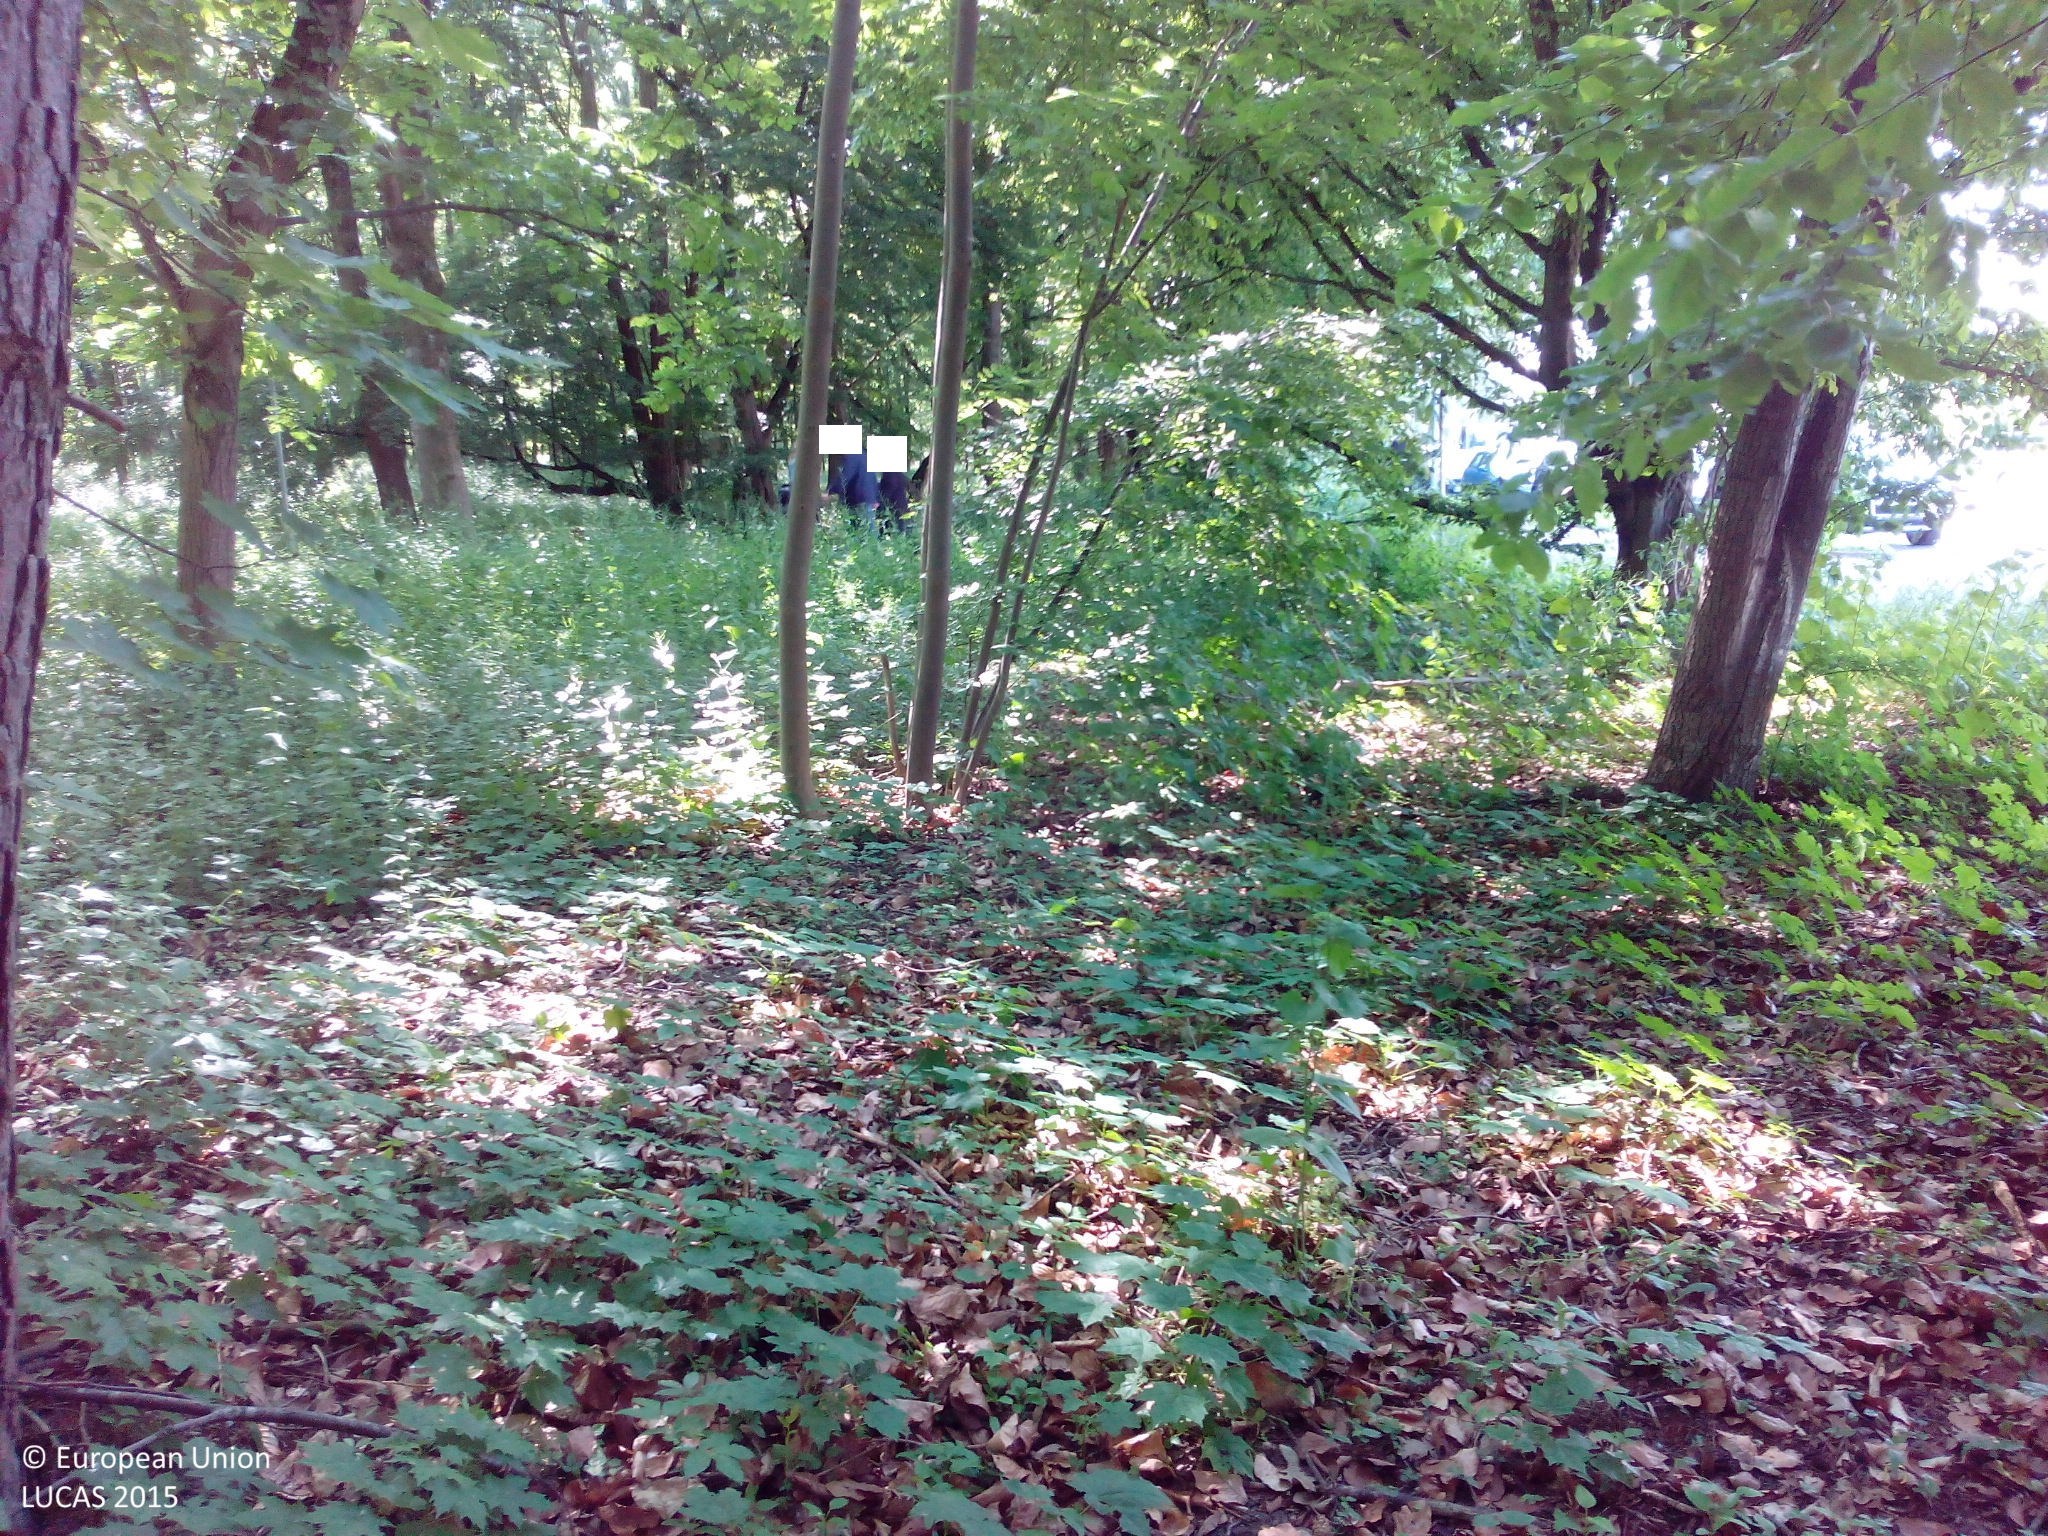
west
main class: Woodland
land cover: Broadleaved woodland
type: mesophytic deciduous forest
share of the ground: > 75 %
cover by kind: broadleaved forest trees 90 %, coniferous forest trees 5 %, herbaceous plants 5 %
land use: Amenities, museums, leisure
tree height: > 5 m
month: May
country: DE
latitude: 48.7722
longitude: 11.4281
